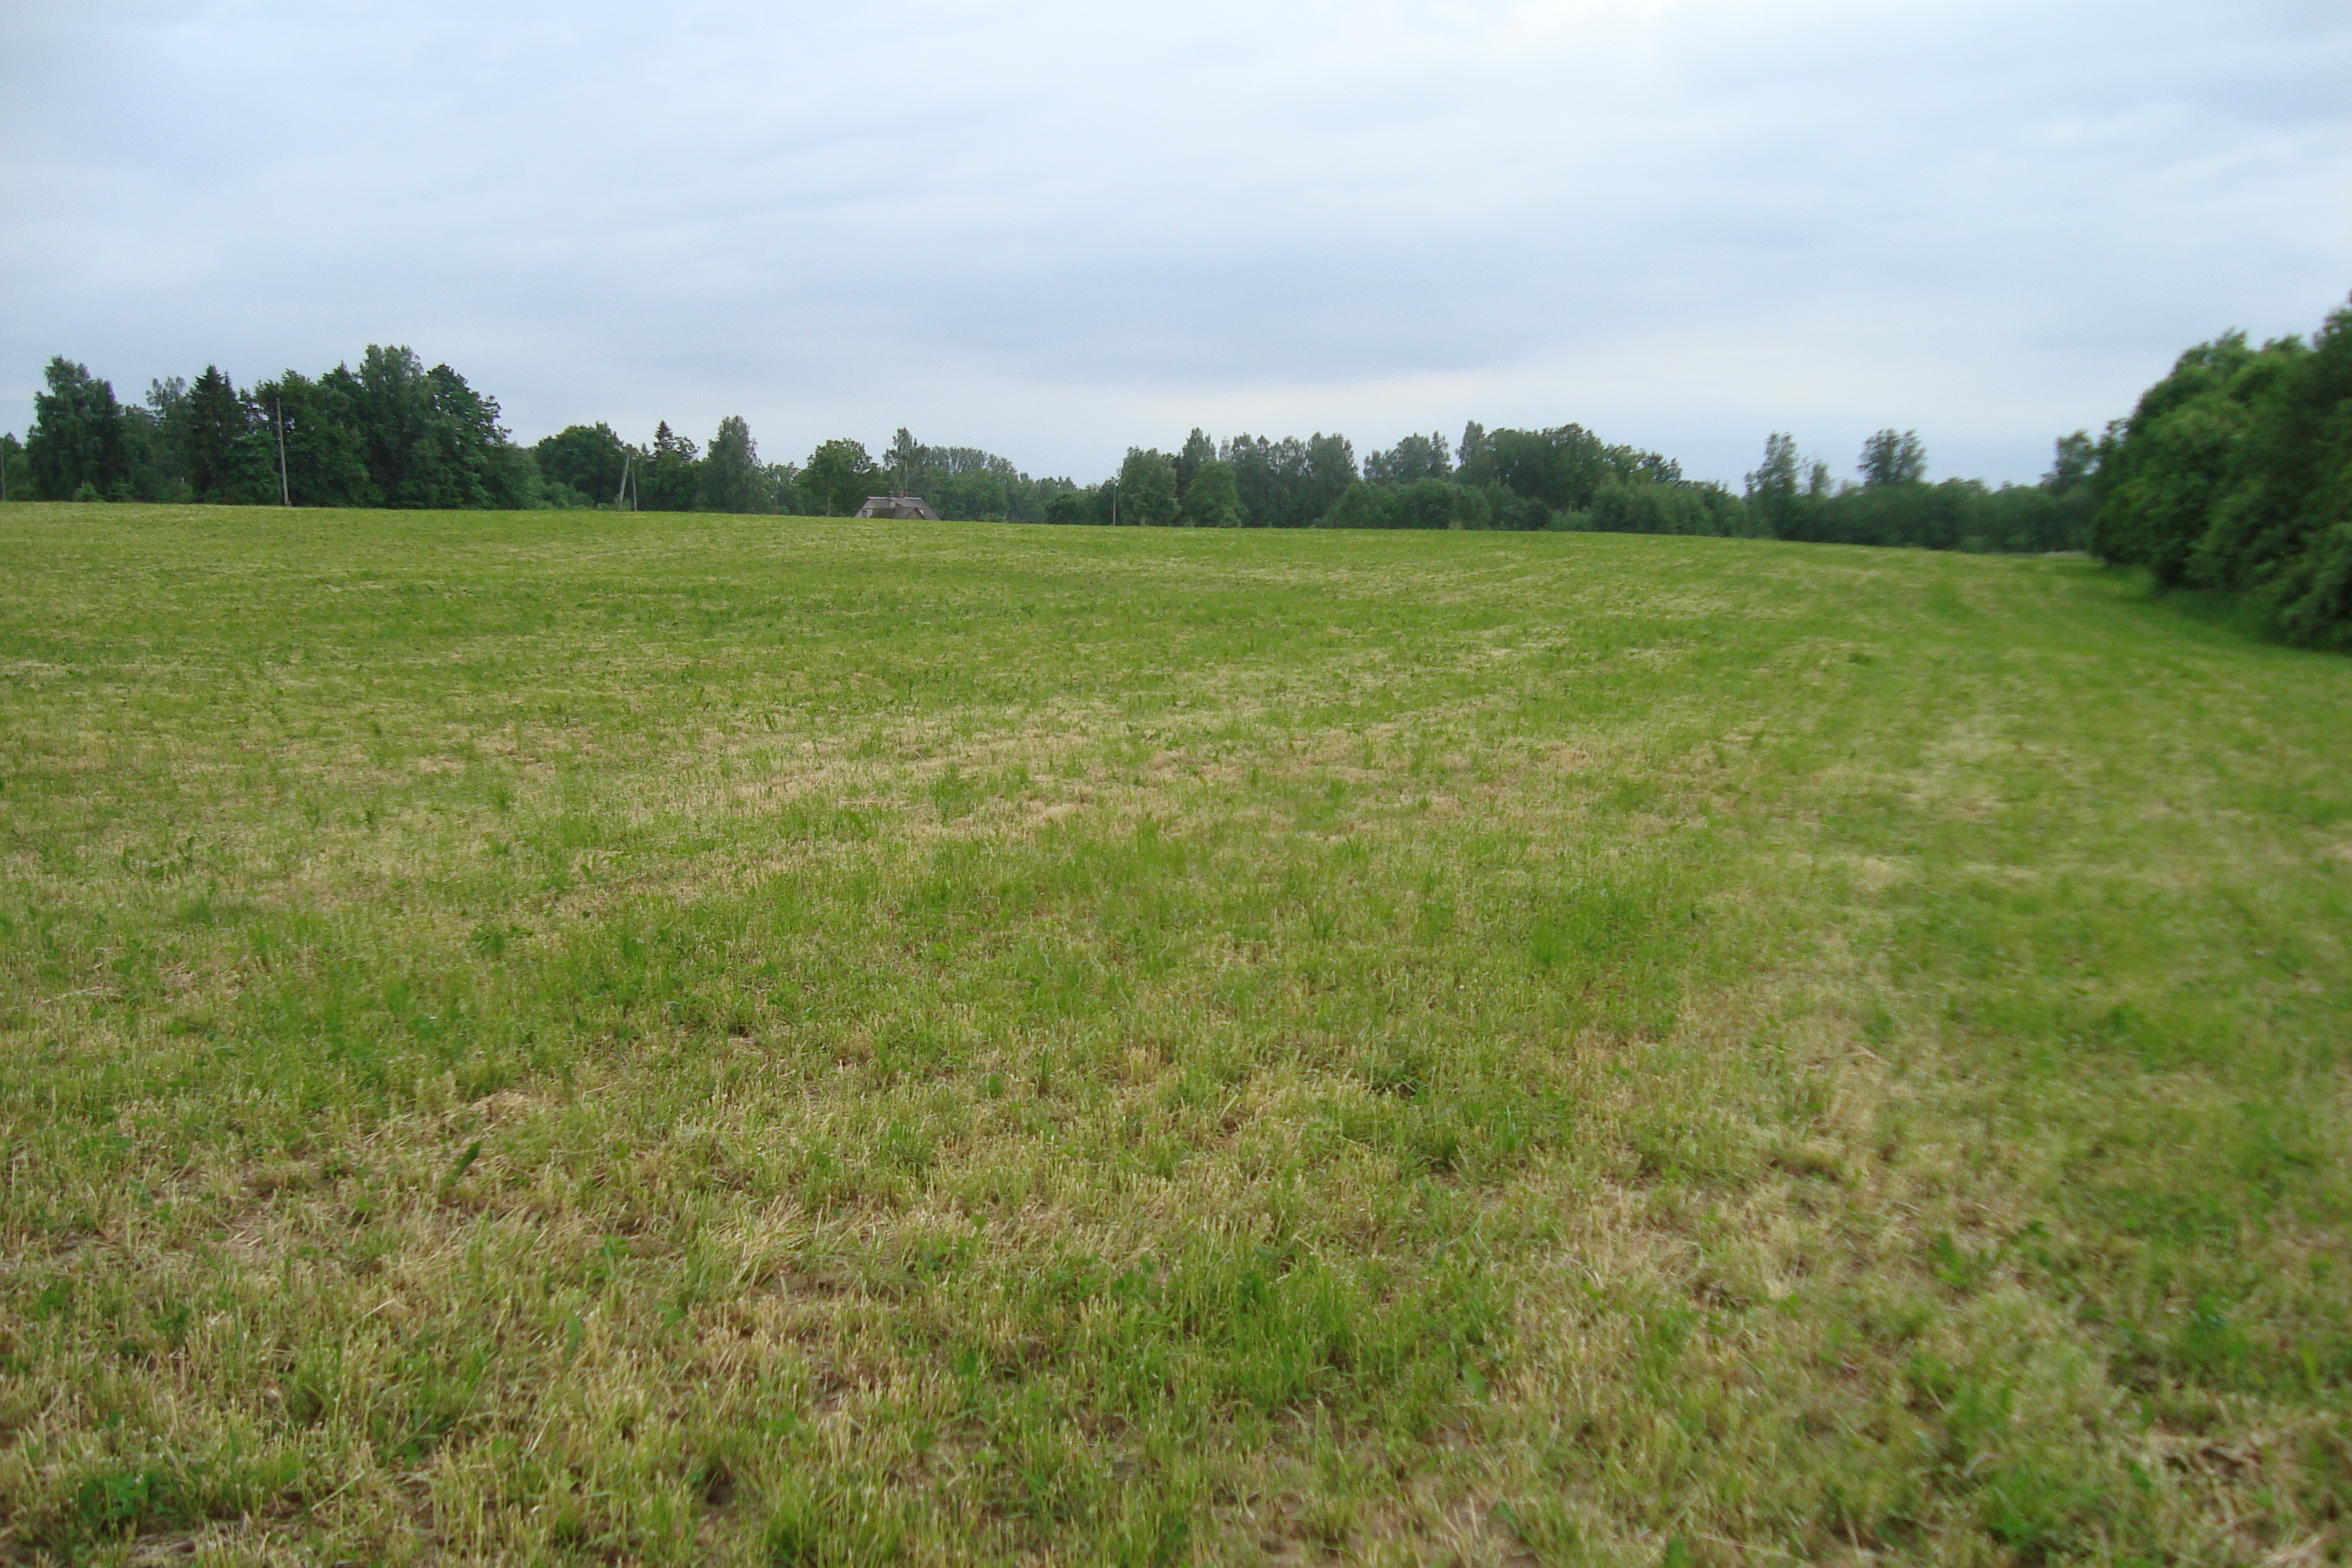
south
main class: Cropland
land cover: Lucerne
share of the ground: > 75 %
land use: Agriculture (excluding fallow land and kitchen gardens)
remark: Harvested field
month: June
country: LV
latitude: 57.2038
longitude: 26.3796
